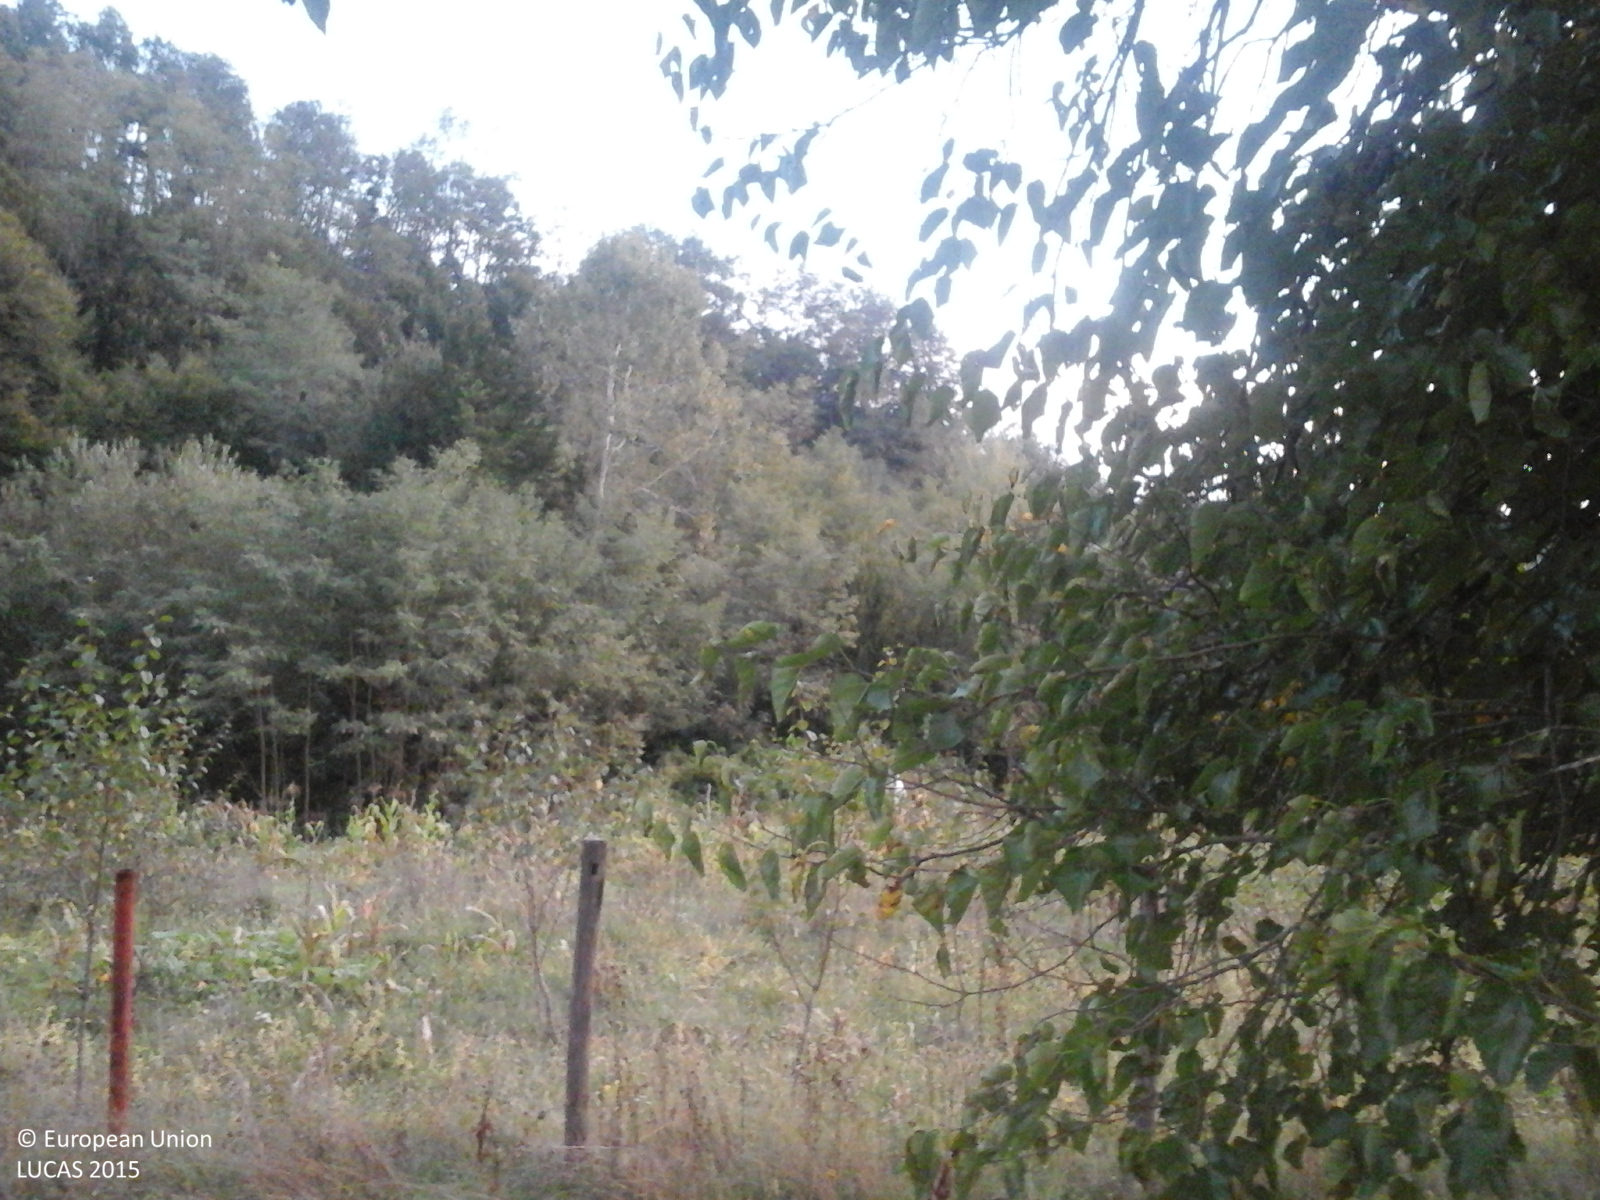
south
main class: Grassland
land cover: Grassland with sparse tree/shrub cover
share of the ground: > 75 %
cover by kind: herbaceous plants 85 %, shrubs 10 %, broadleaved forest trees 5 %
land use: Fallow land
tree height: > 5 m
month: September
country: RO
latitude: 44.9137
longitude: 23.4446
